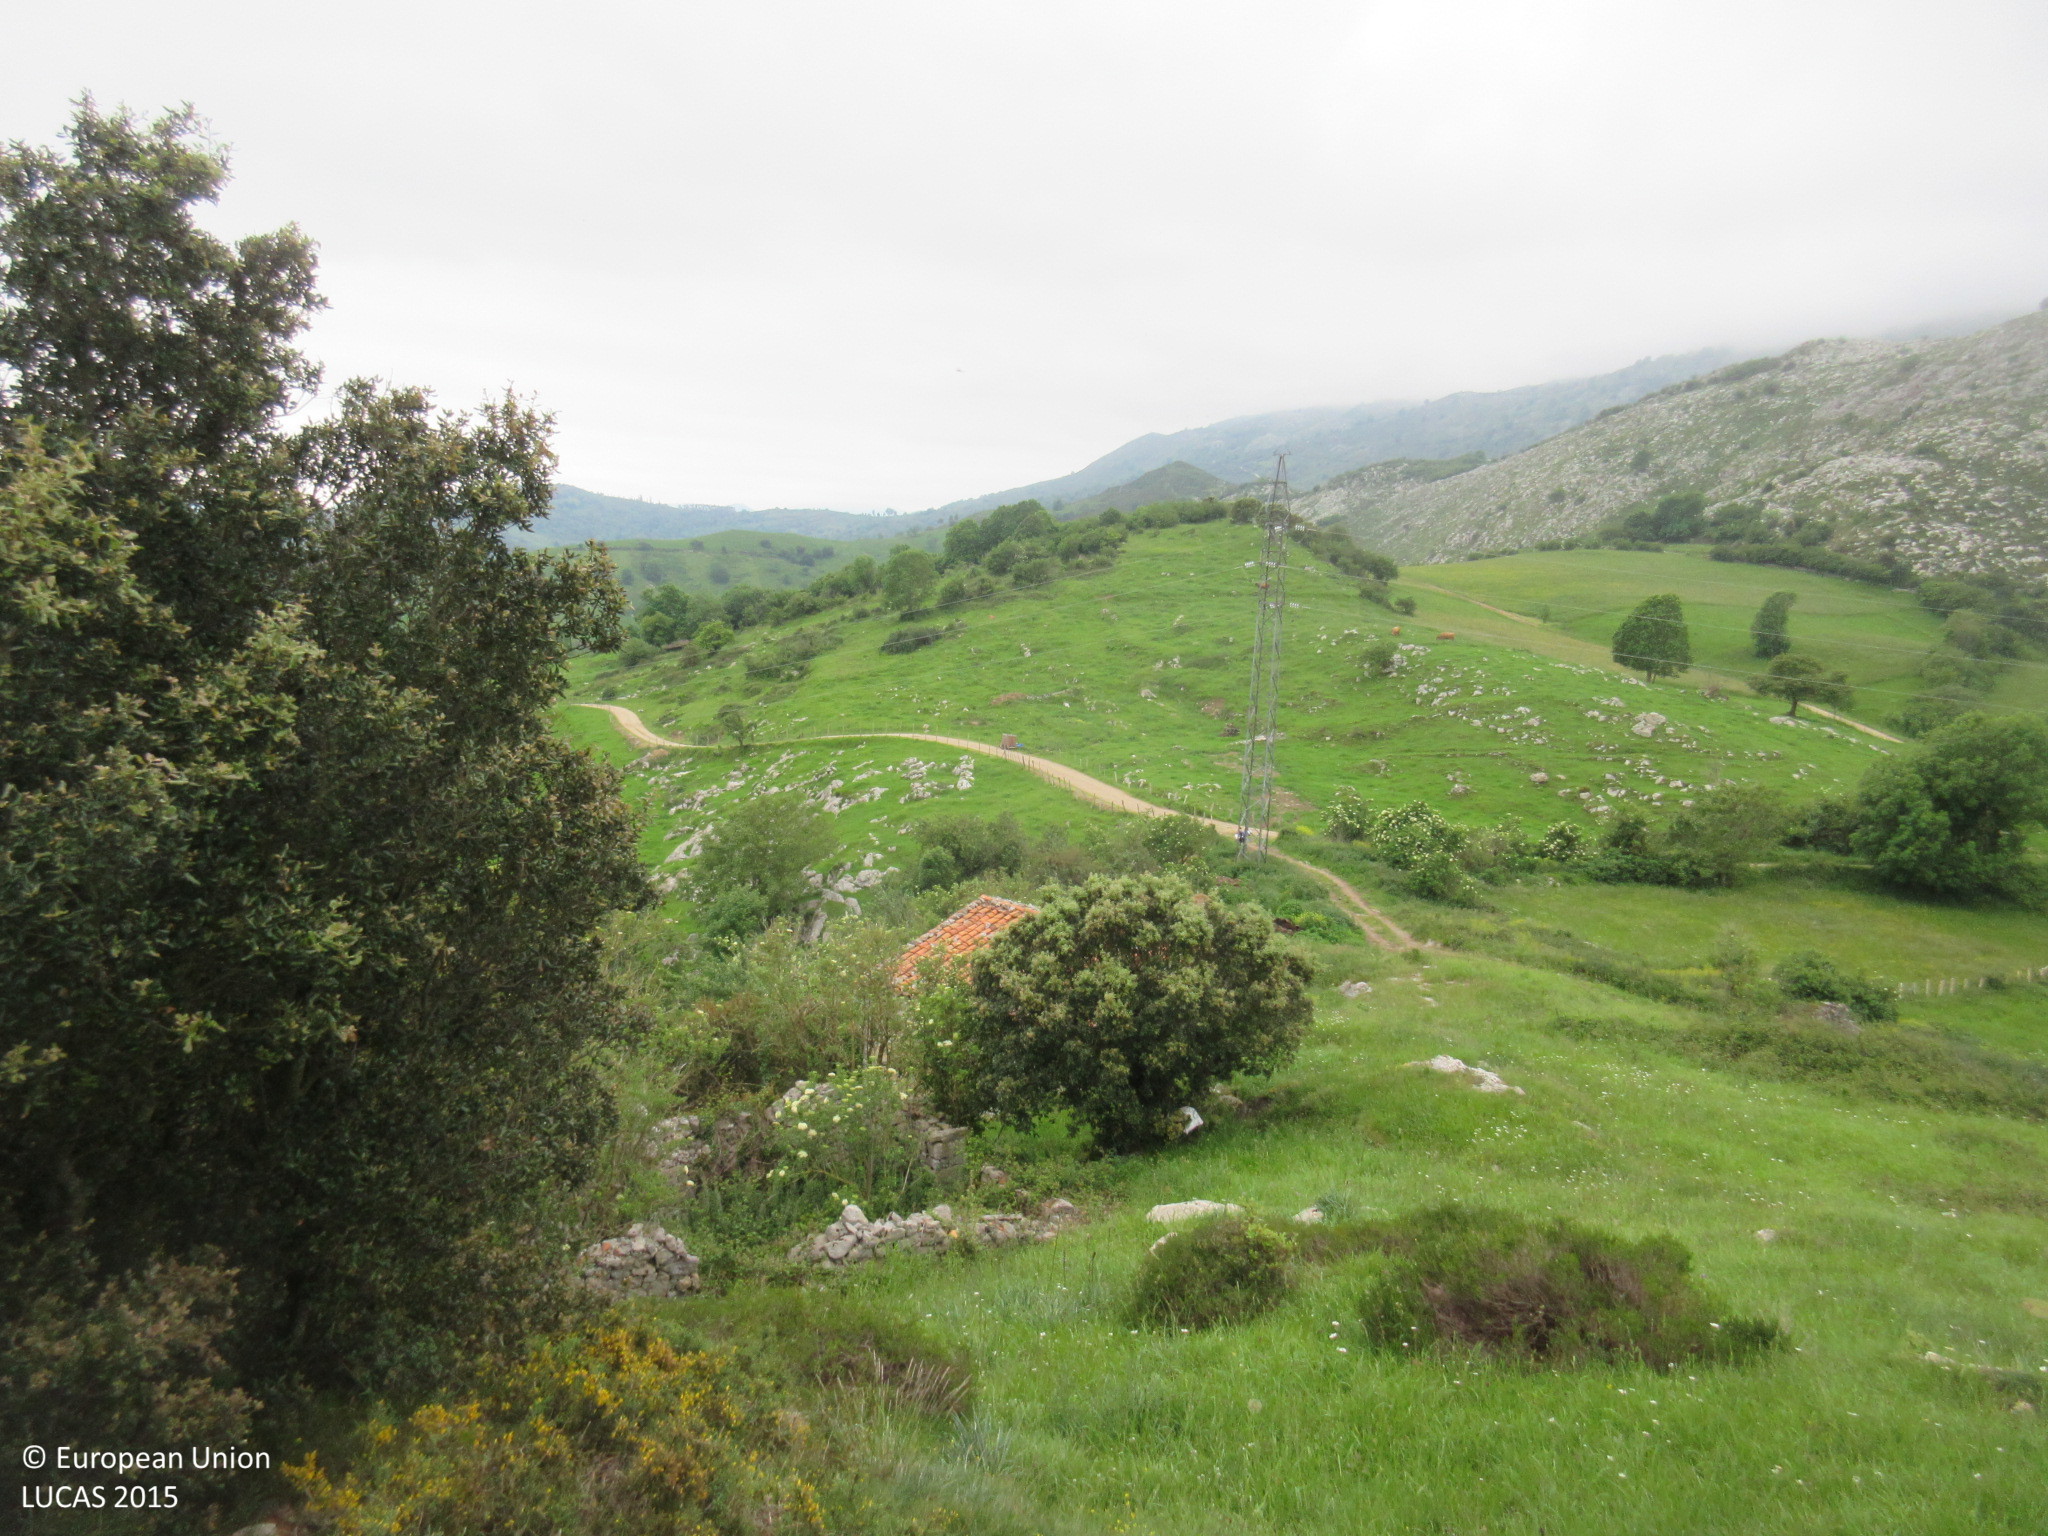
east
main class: Shrubland
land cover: Shrubland with sparse tree cover
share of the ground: > 75 %
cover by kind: shrubs 95 %, broadleaved forest trees 5 %
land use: Semi-natural and natural areas not in use
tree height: < 5 m
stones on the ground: > 50 %
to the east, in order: Shrubland with sparse tree cover; Broadleaved woodland; Dry stone walls; Grassland with sparse tree/shrub cover; Rock outcrops; Grassland with sparse tree/shrub cover; Electric lines; Grassland without tree/shrub cover; Grassland with sparse tree/shrub cover
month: May
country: ES
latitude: 43.3117
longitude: -4.5977
